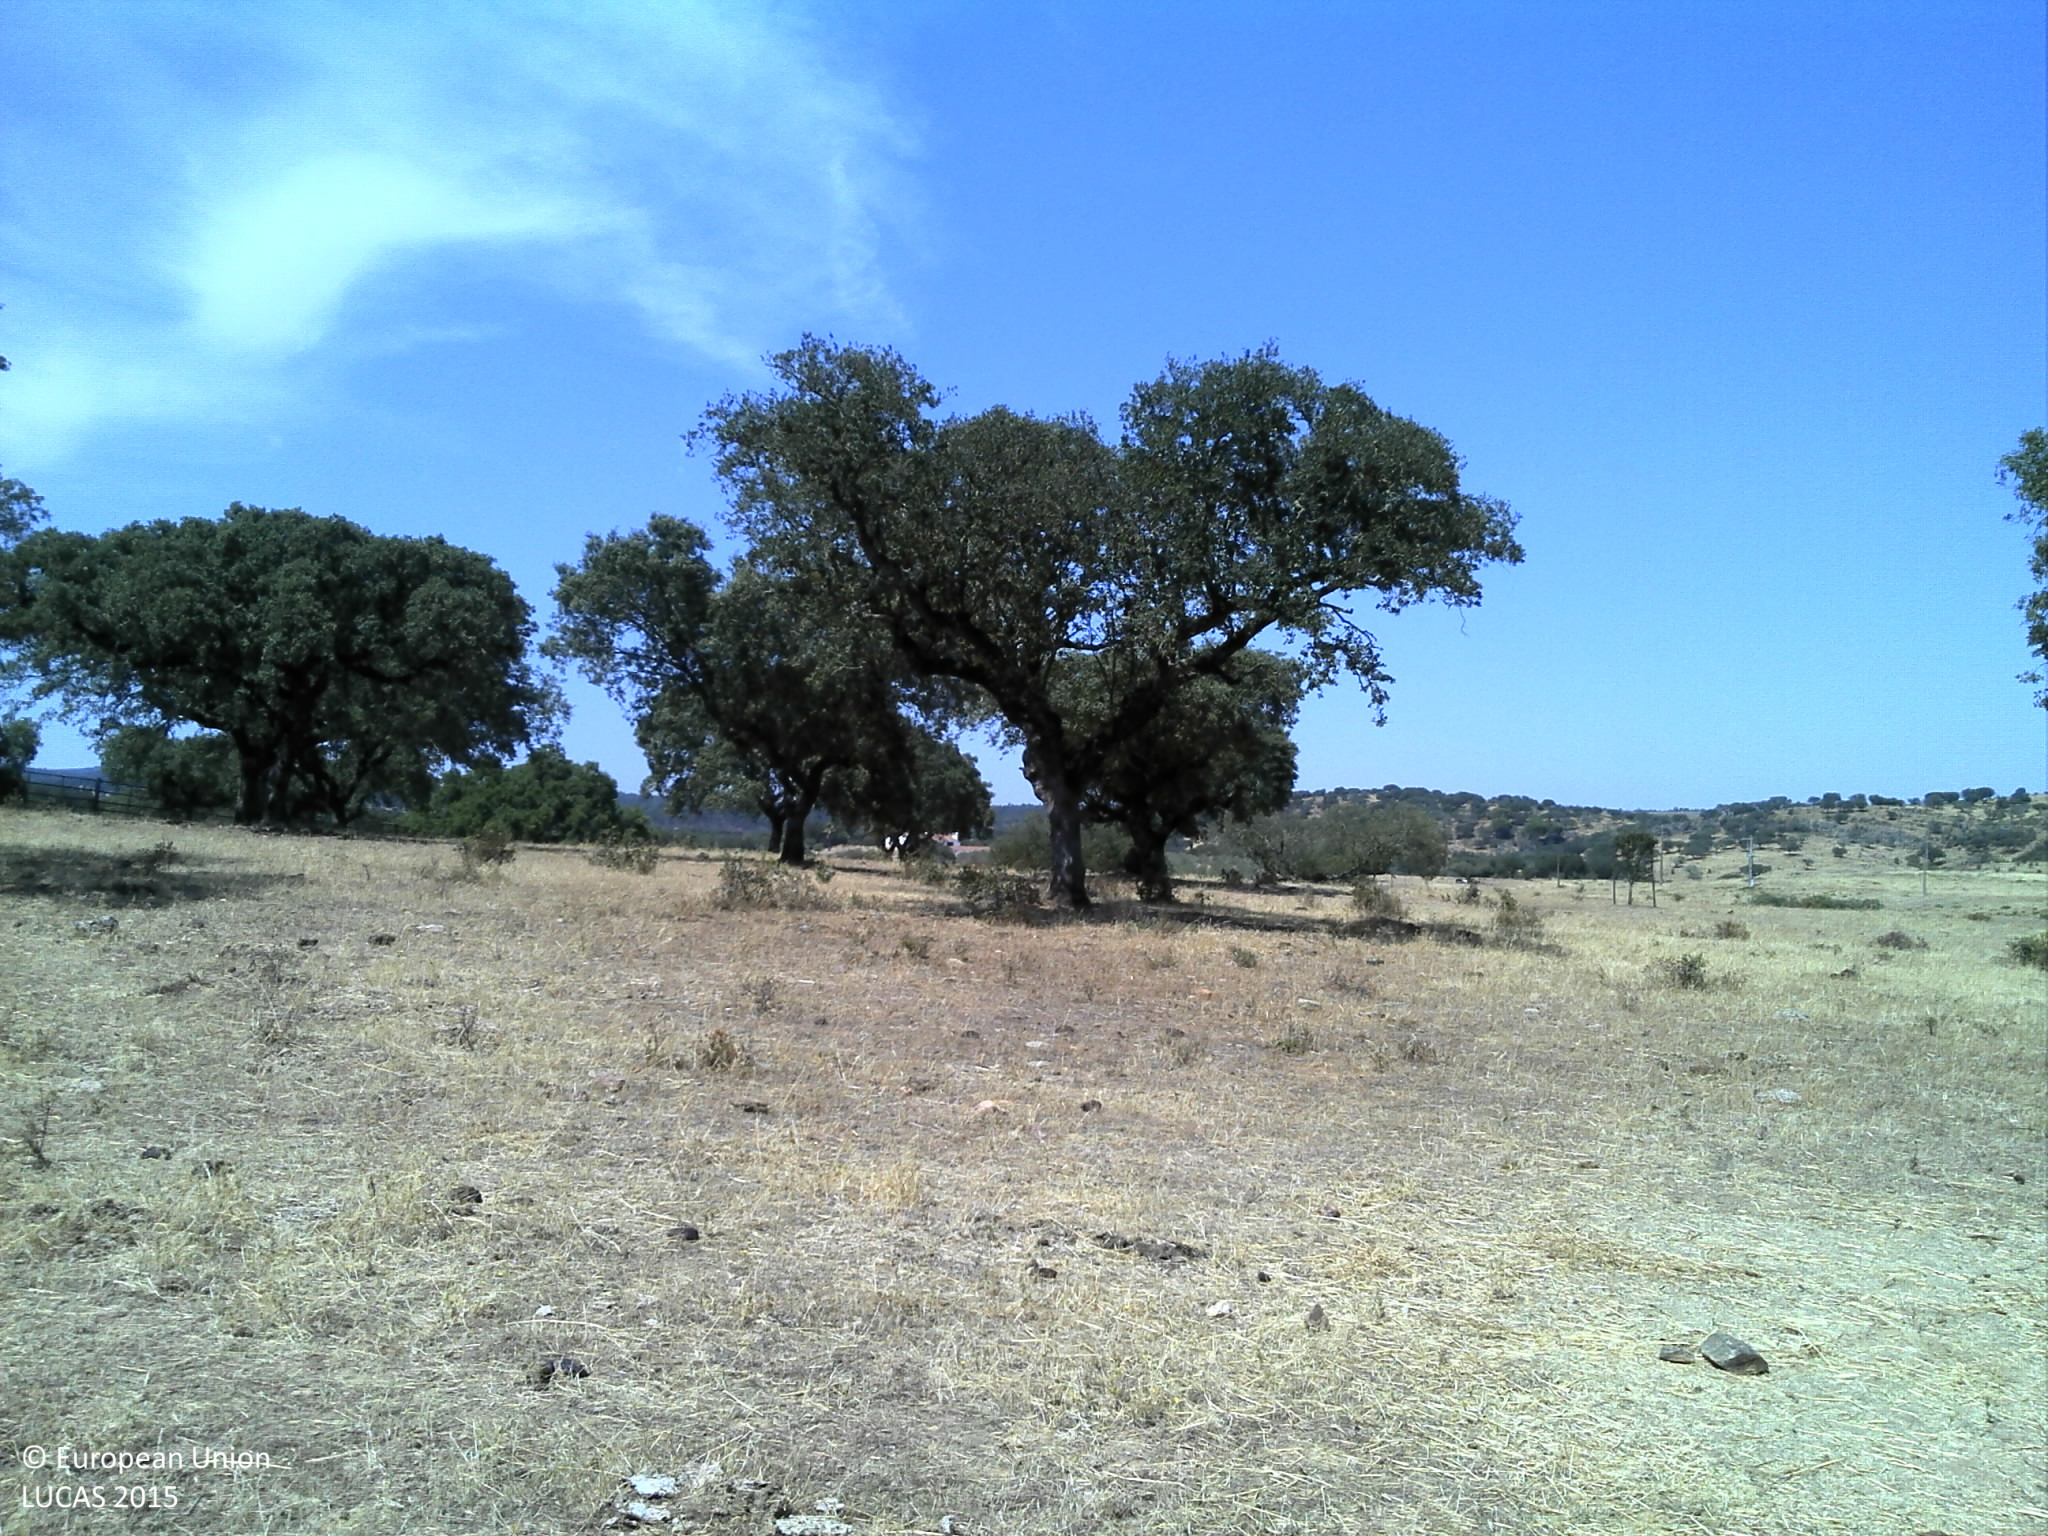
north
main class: Woodland
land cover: Broadleaved woodland
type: broadleaved evergreen forest
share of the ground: 25 - 50 %
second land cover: Grassland without tree/shrub cover
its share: 10 - 25 %
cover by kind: unconsolidated bare surface 50 %, broadleaved forest trees 25 %, herbaceous plants 25 %
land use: Forestry
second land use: Agriculture (excluding fallow land and kitchen gardens)
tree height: > 5 m
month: July
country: PT
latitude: 38.6777
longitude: -7.5157
